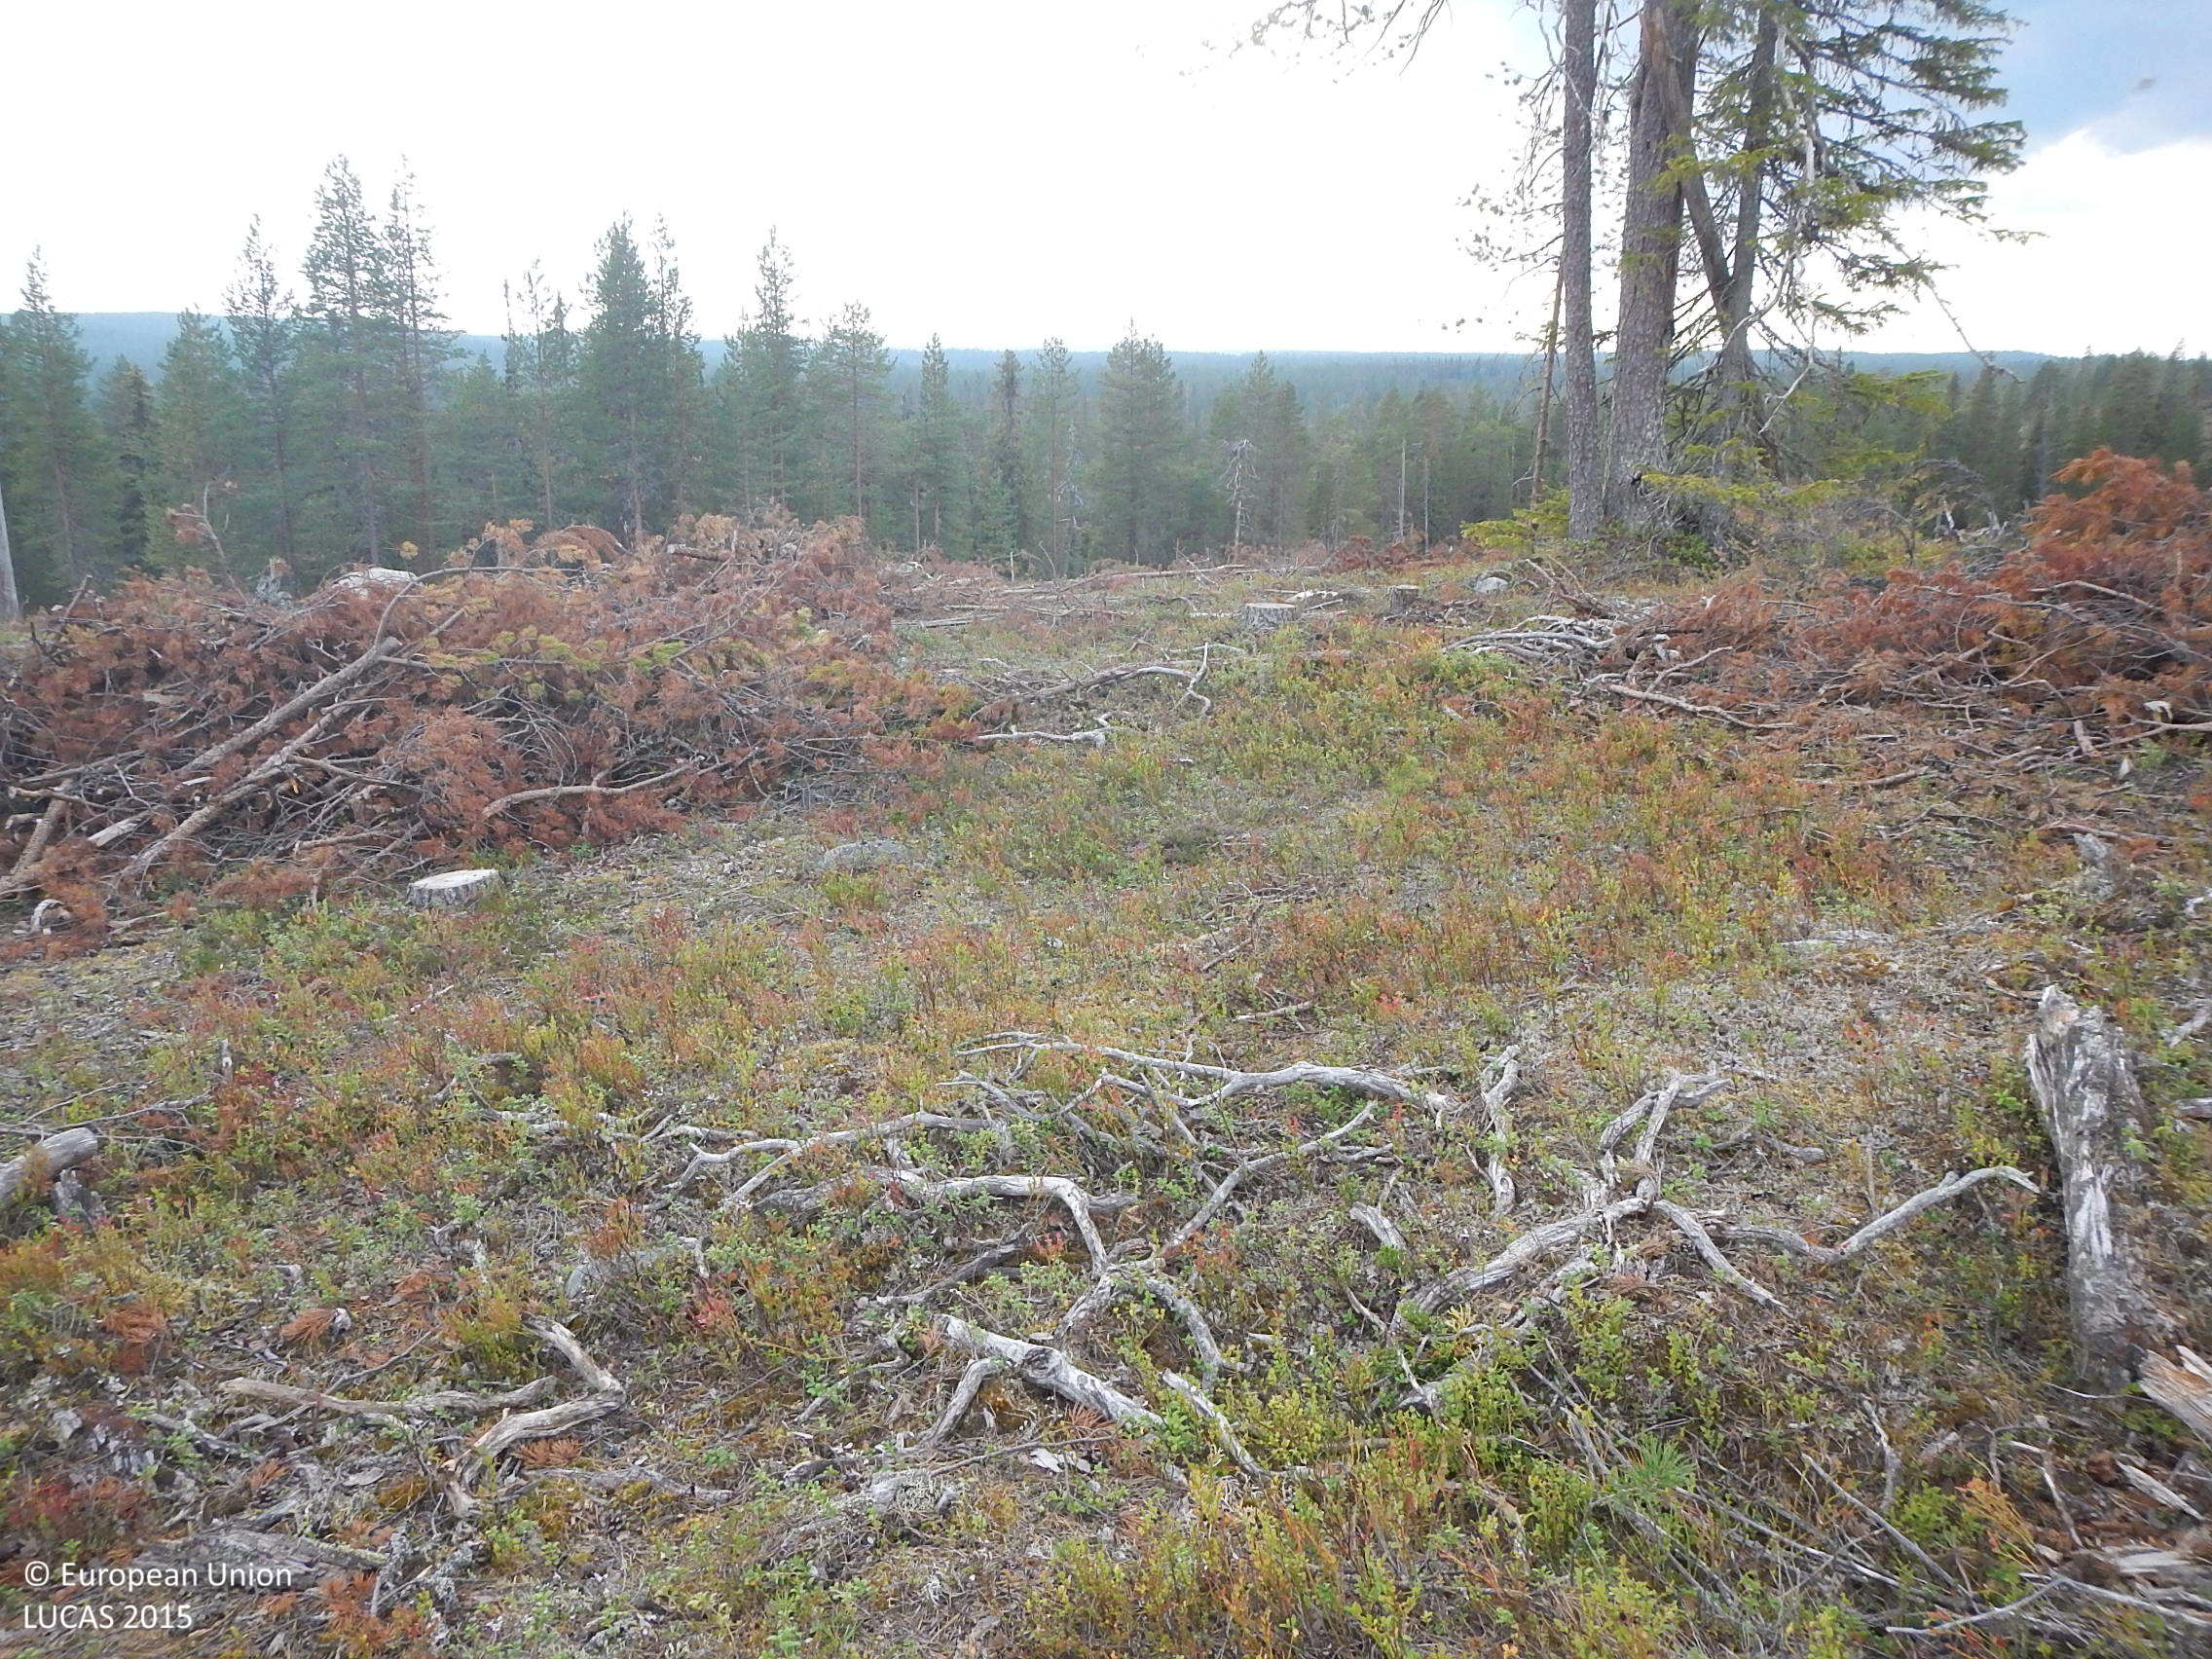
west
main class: Shrubland
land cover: Shrubland with sparse tree cover
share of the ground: > 75 %
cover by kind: shrubs 75 %, lichens and mosses 10 %, unconsolidated bare surface 10 %, coniferous forest trees 5 %
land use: Forestry
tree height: < 5 m
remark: Clear cut
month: August
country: FI
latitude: 66.0571
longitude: 27.8645
